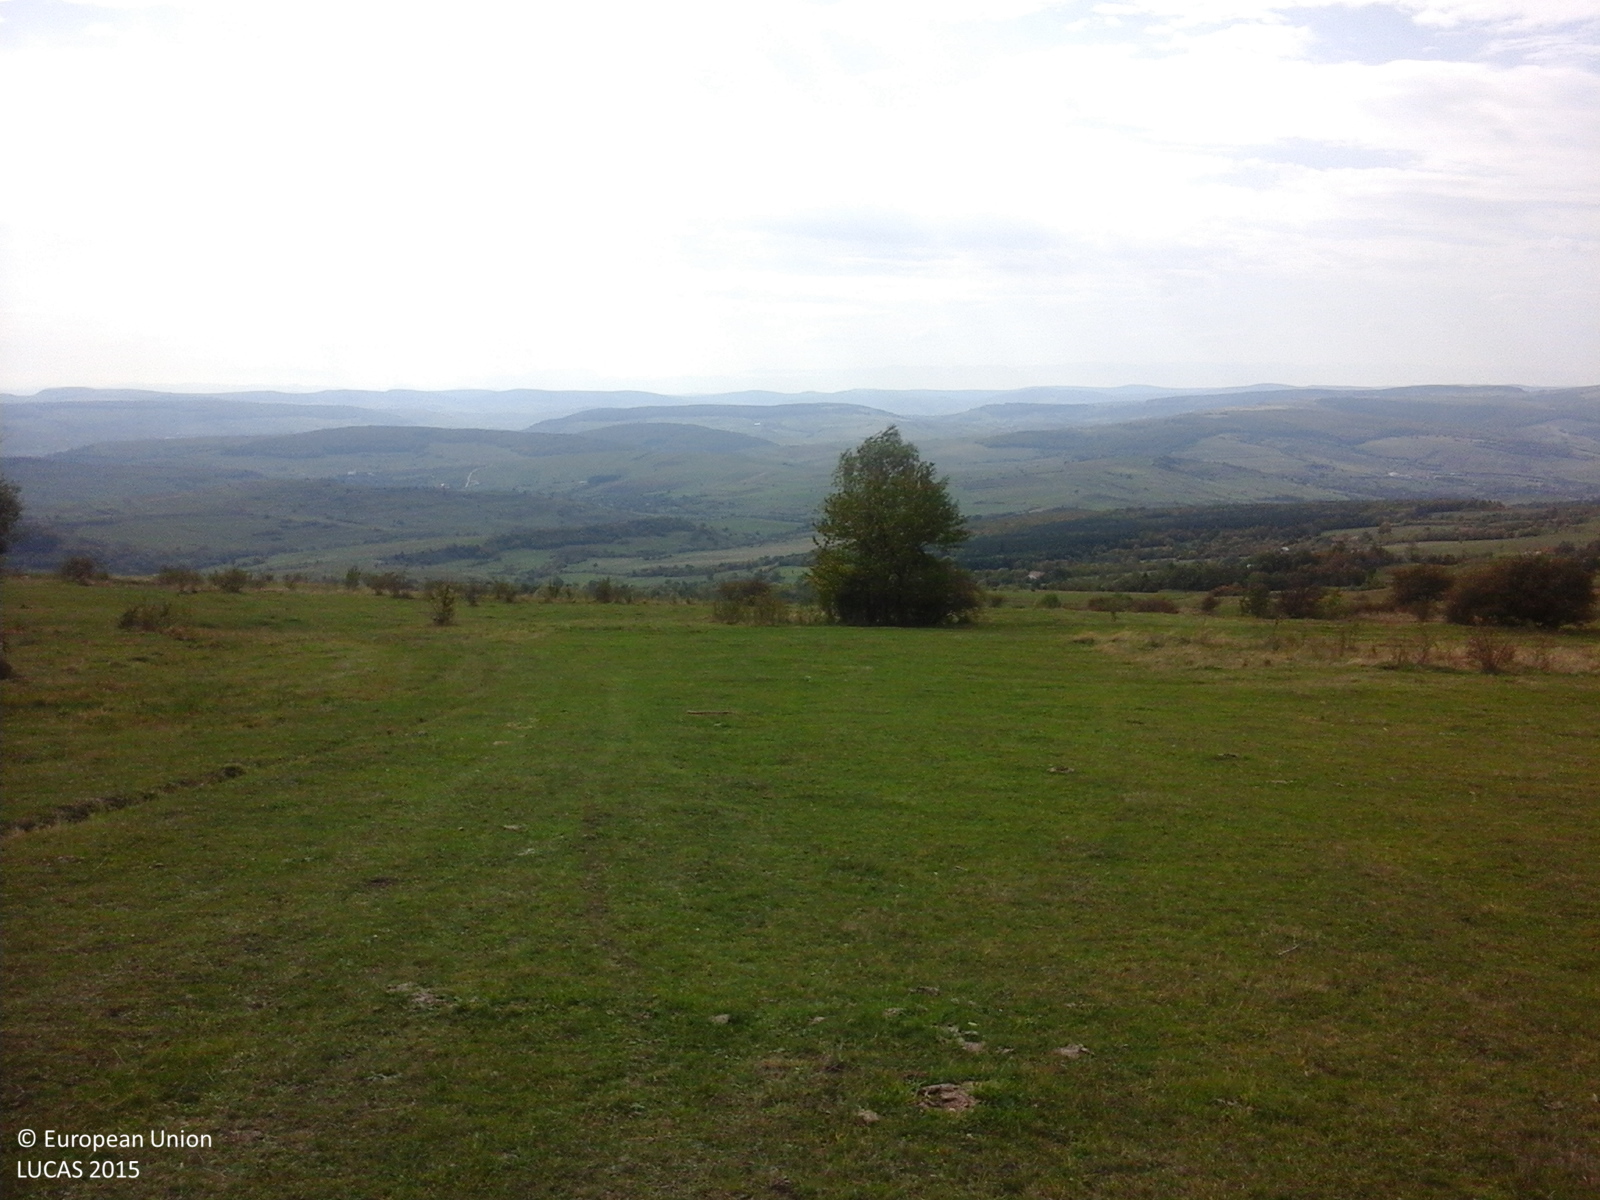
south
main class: Grassland
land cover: Grassland without tree/shrub cover
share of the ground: > 75 %
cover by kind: herbaceous plants 100 %
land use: Agriculture (excluding fallow land and kitchen gardens)
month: October
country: RO
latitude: 46.3991
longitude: 25.2813
